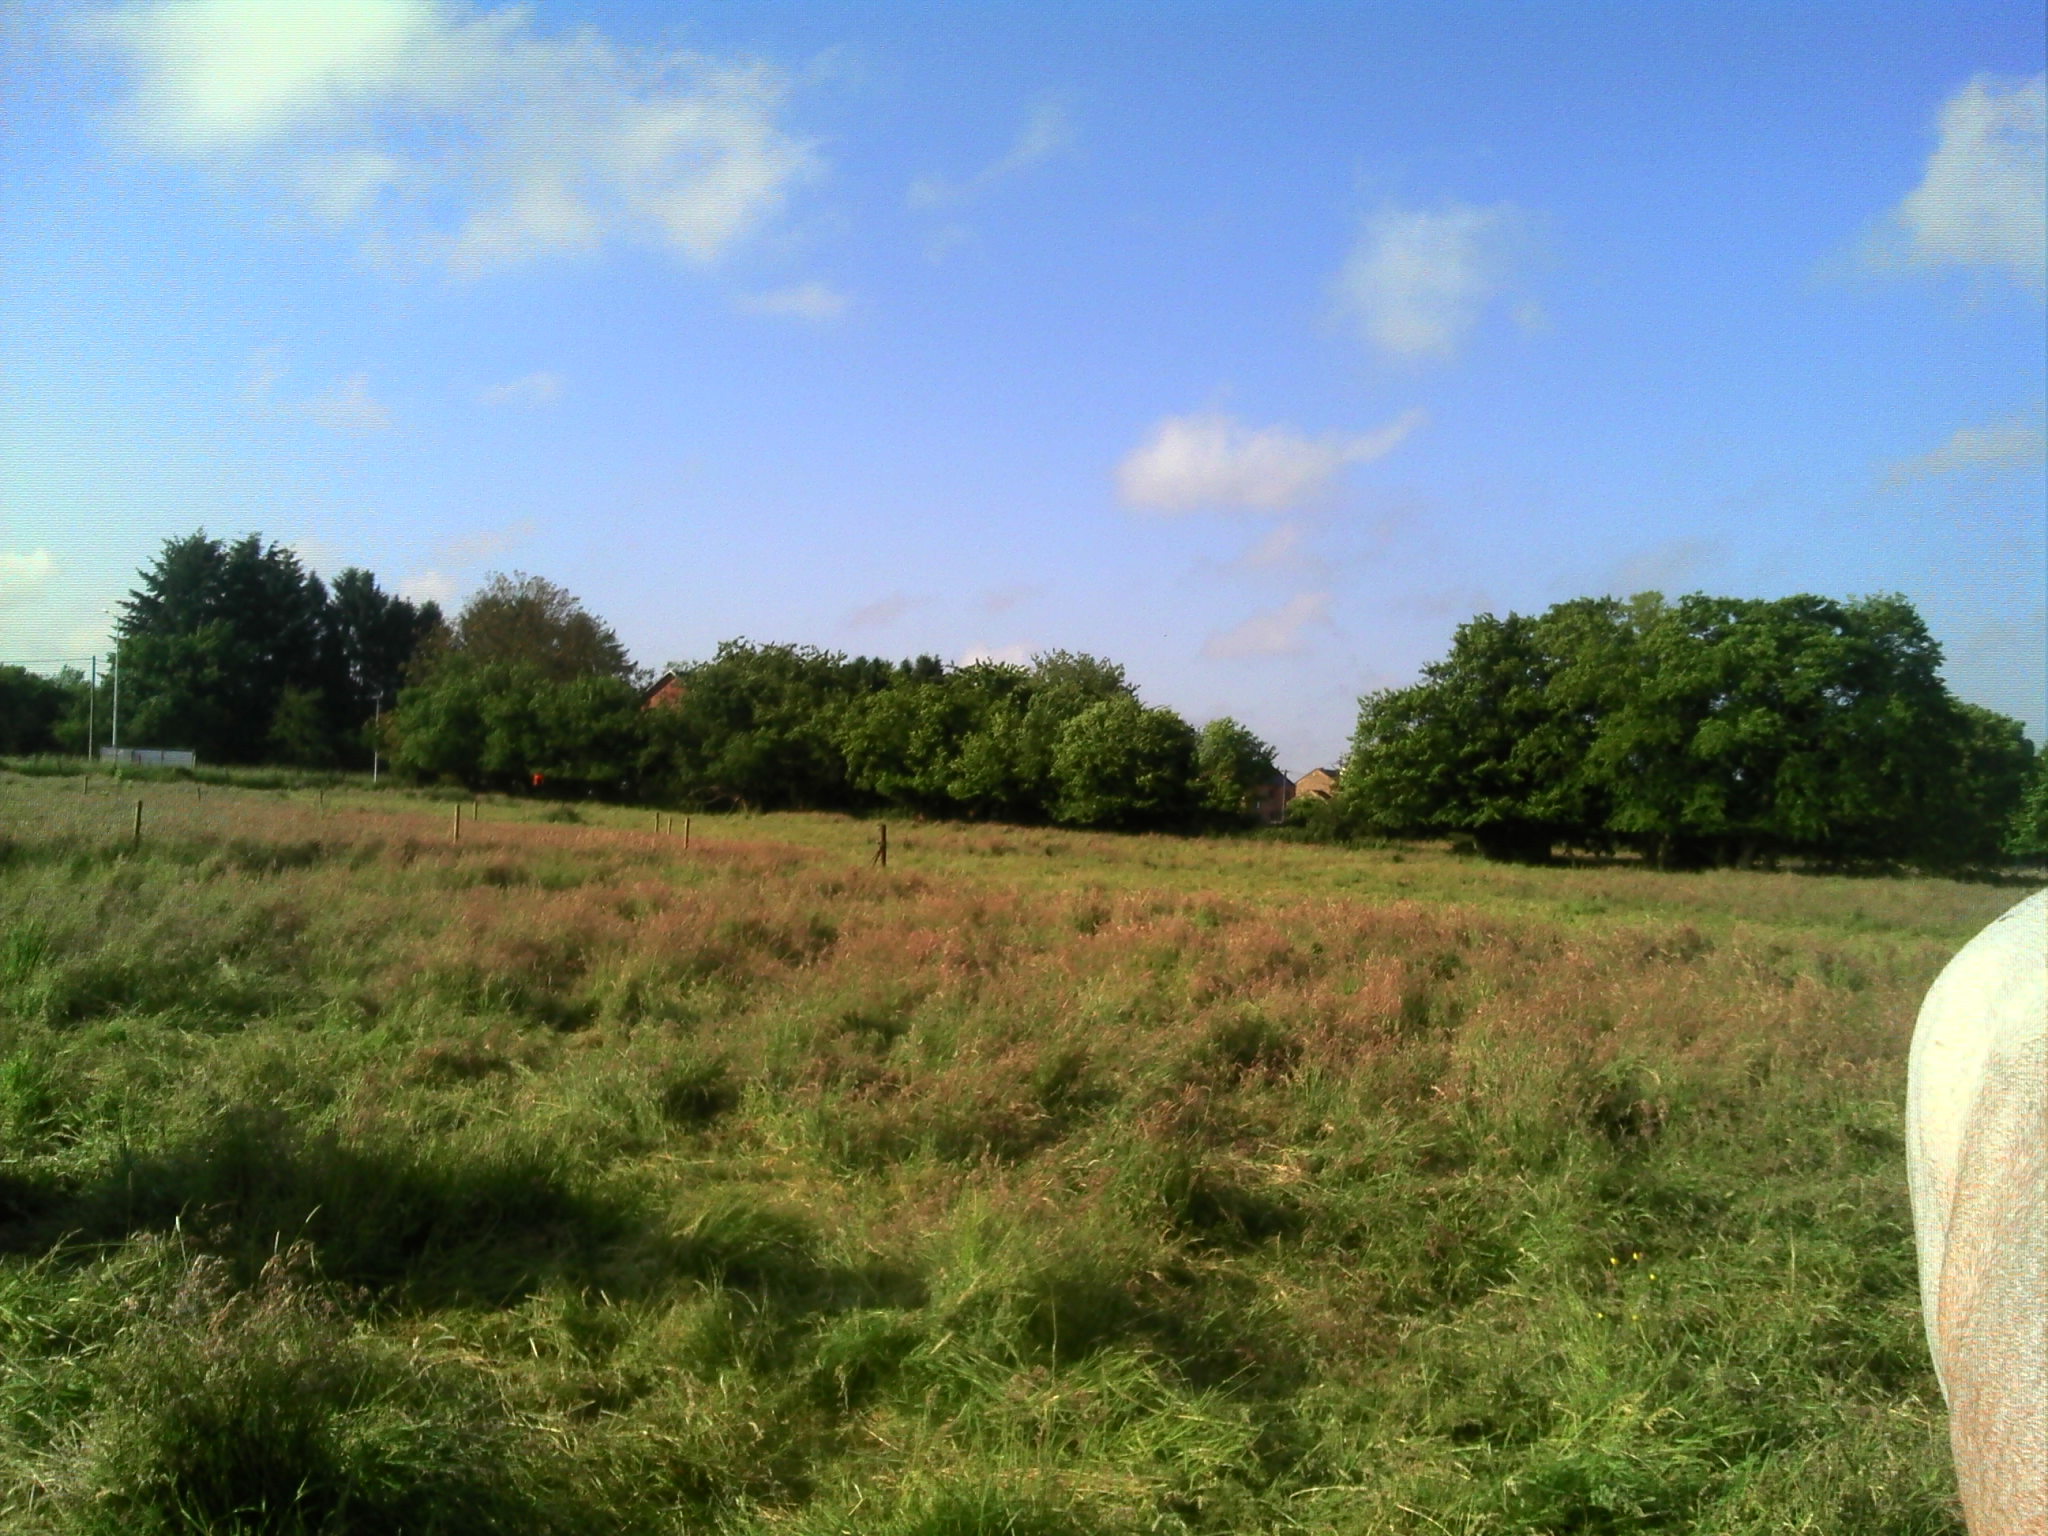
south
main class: Grassland
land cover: Grassland without tree/shrub cover
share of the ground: > 75 %
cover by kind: herbaceous plants 100 %
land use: Agriculture (excluding fallow land and kitchen gardens)
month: June
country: BE
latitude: 50.3903
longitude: 4.8065
